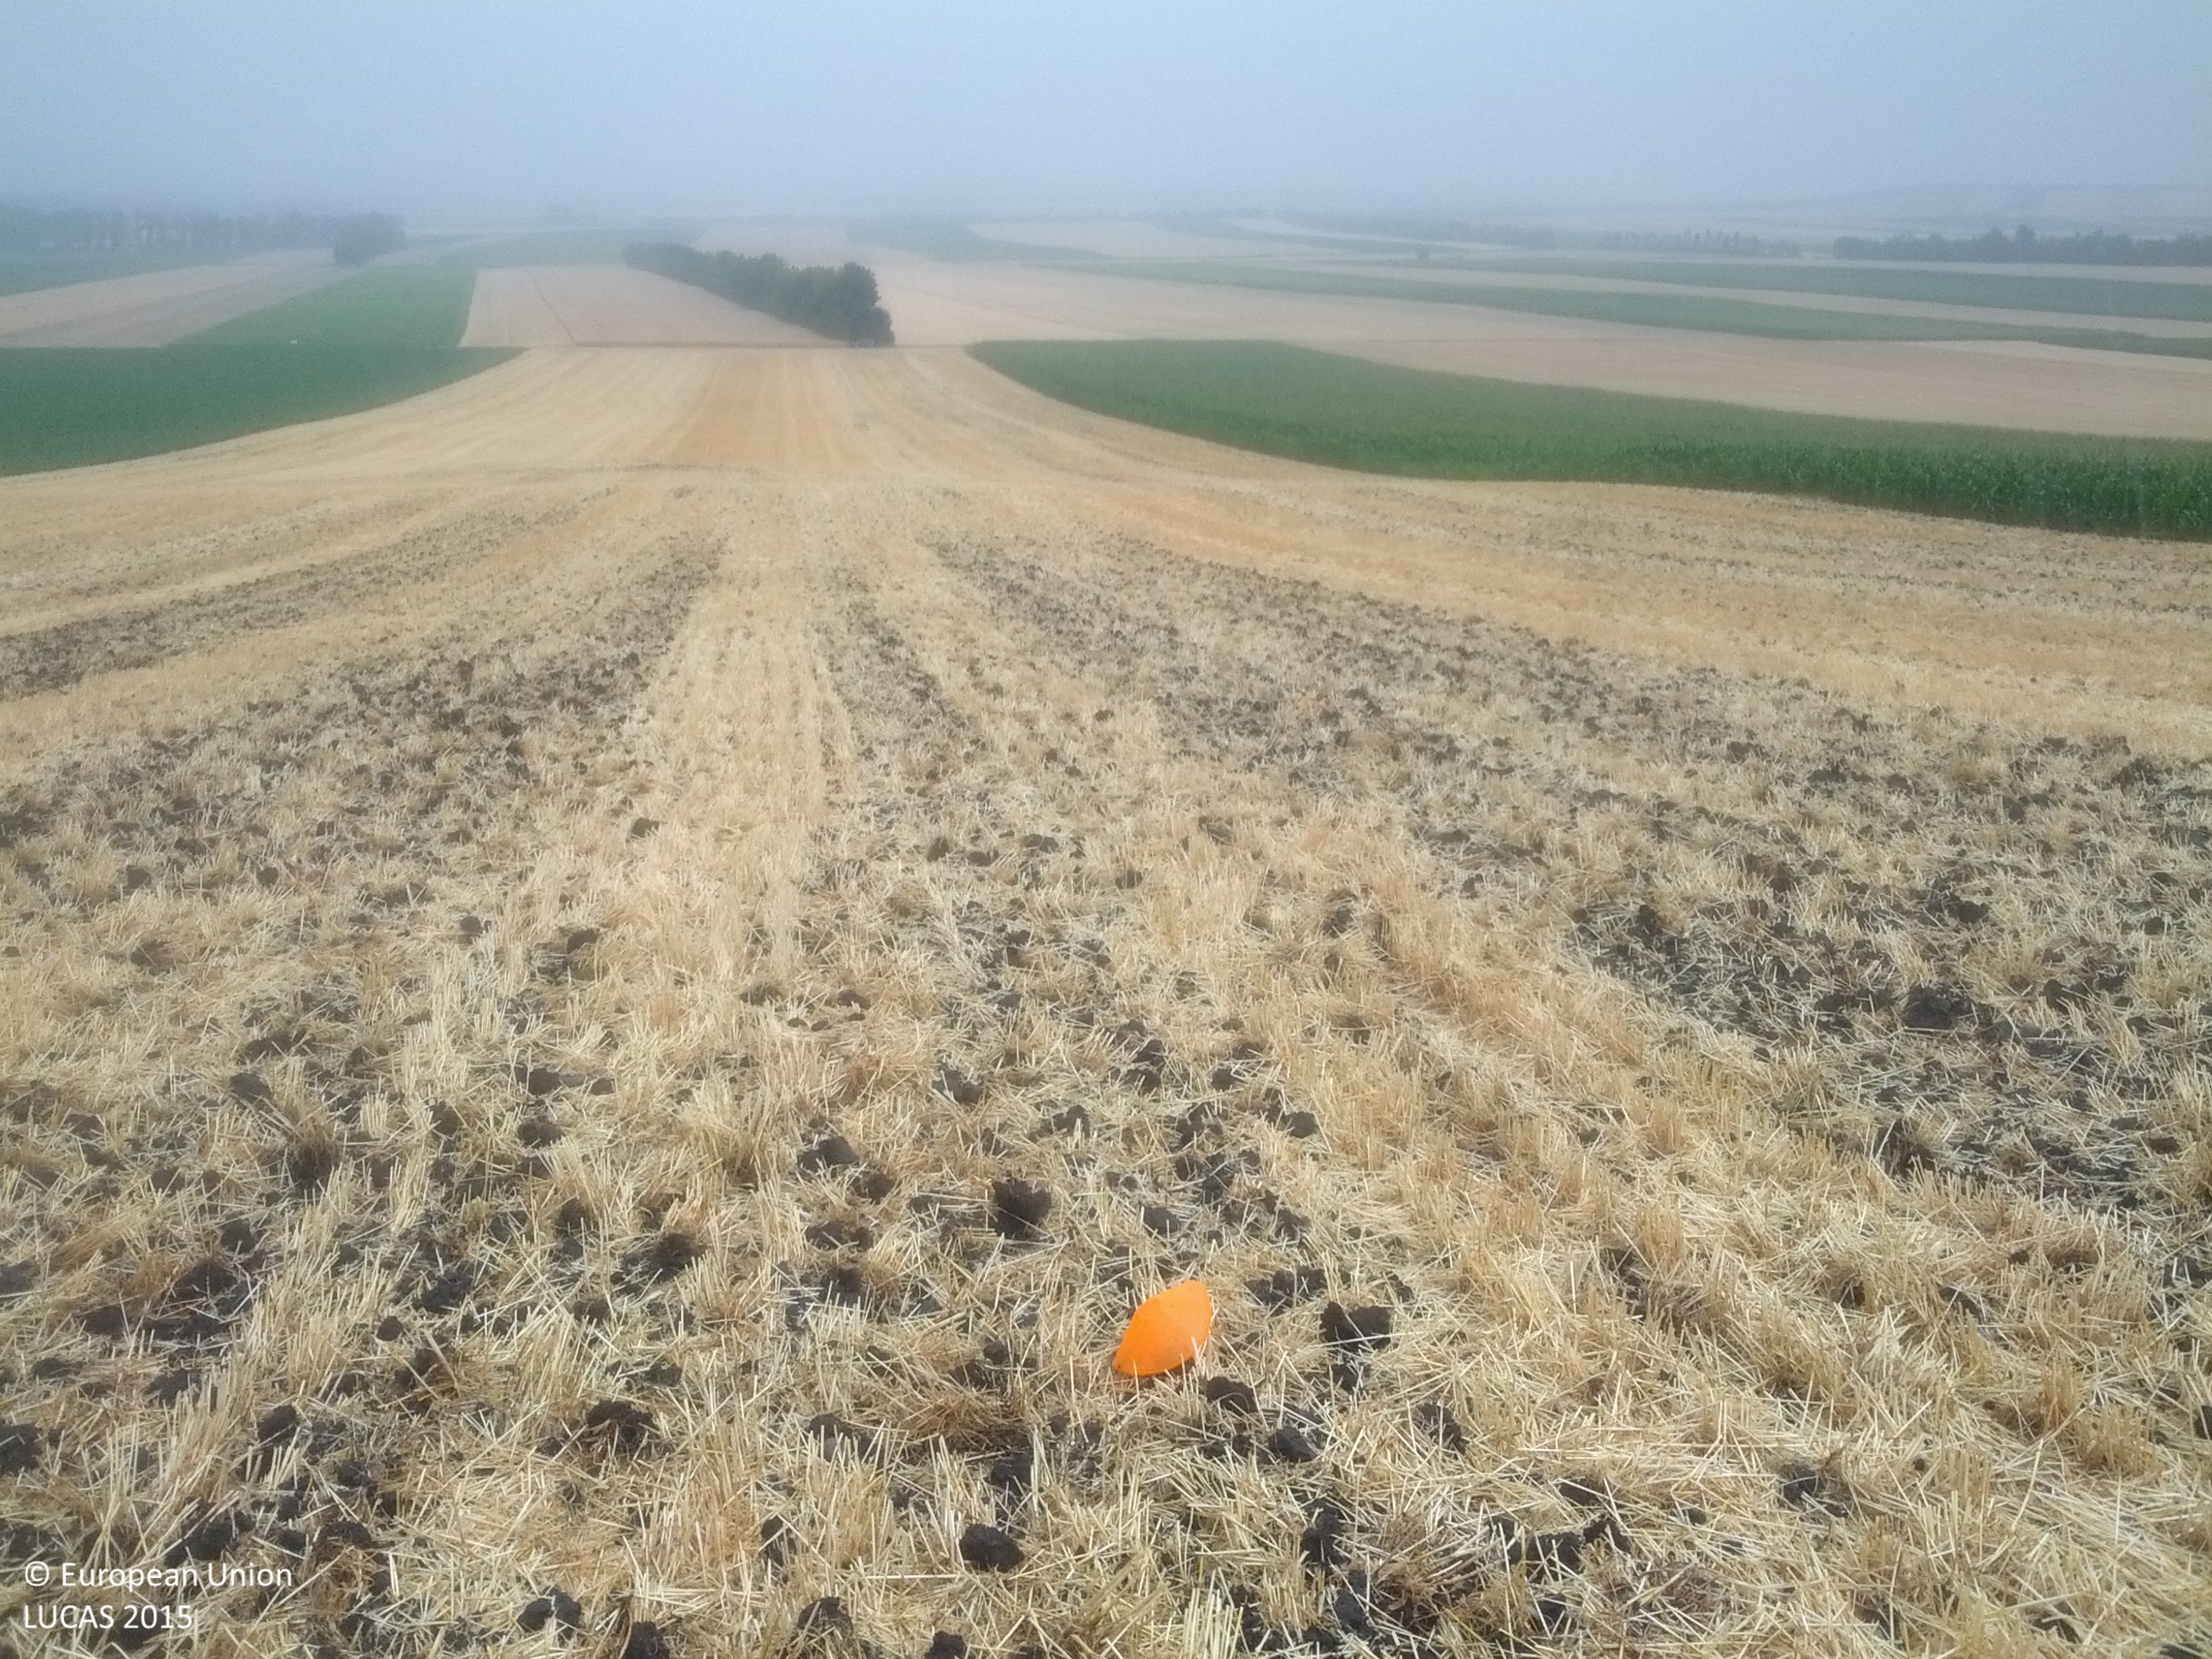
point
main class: Cropland
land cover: Barley
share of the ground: < 10 %
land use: Agriculture (excluding fallow land and kitchen gardens)
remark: Harvested field
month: July
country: AT
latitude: 48.7882
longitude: 16.5263
